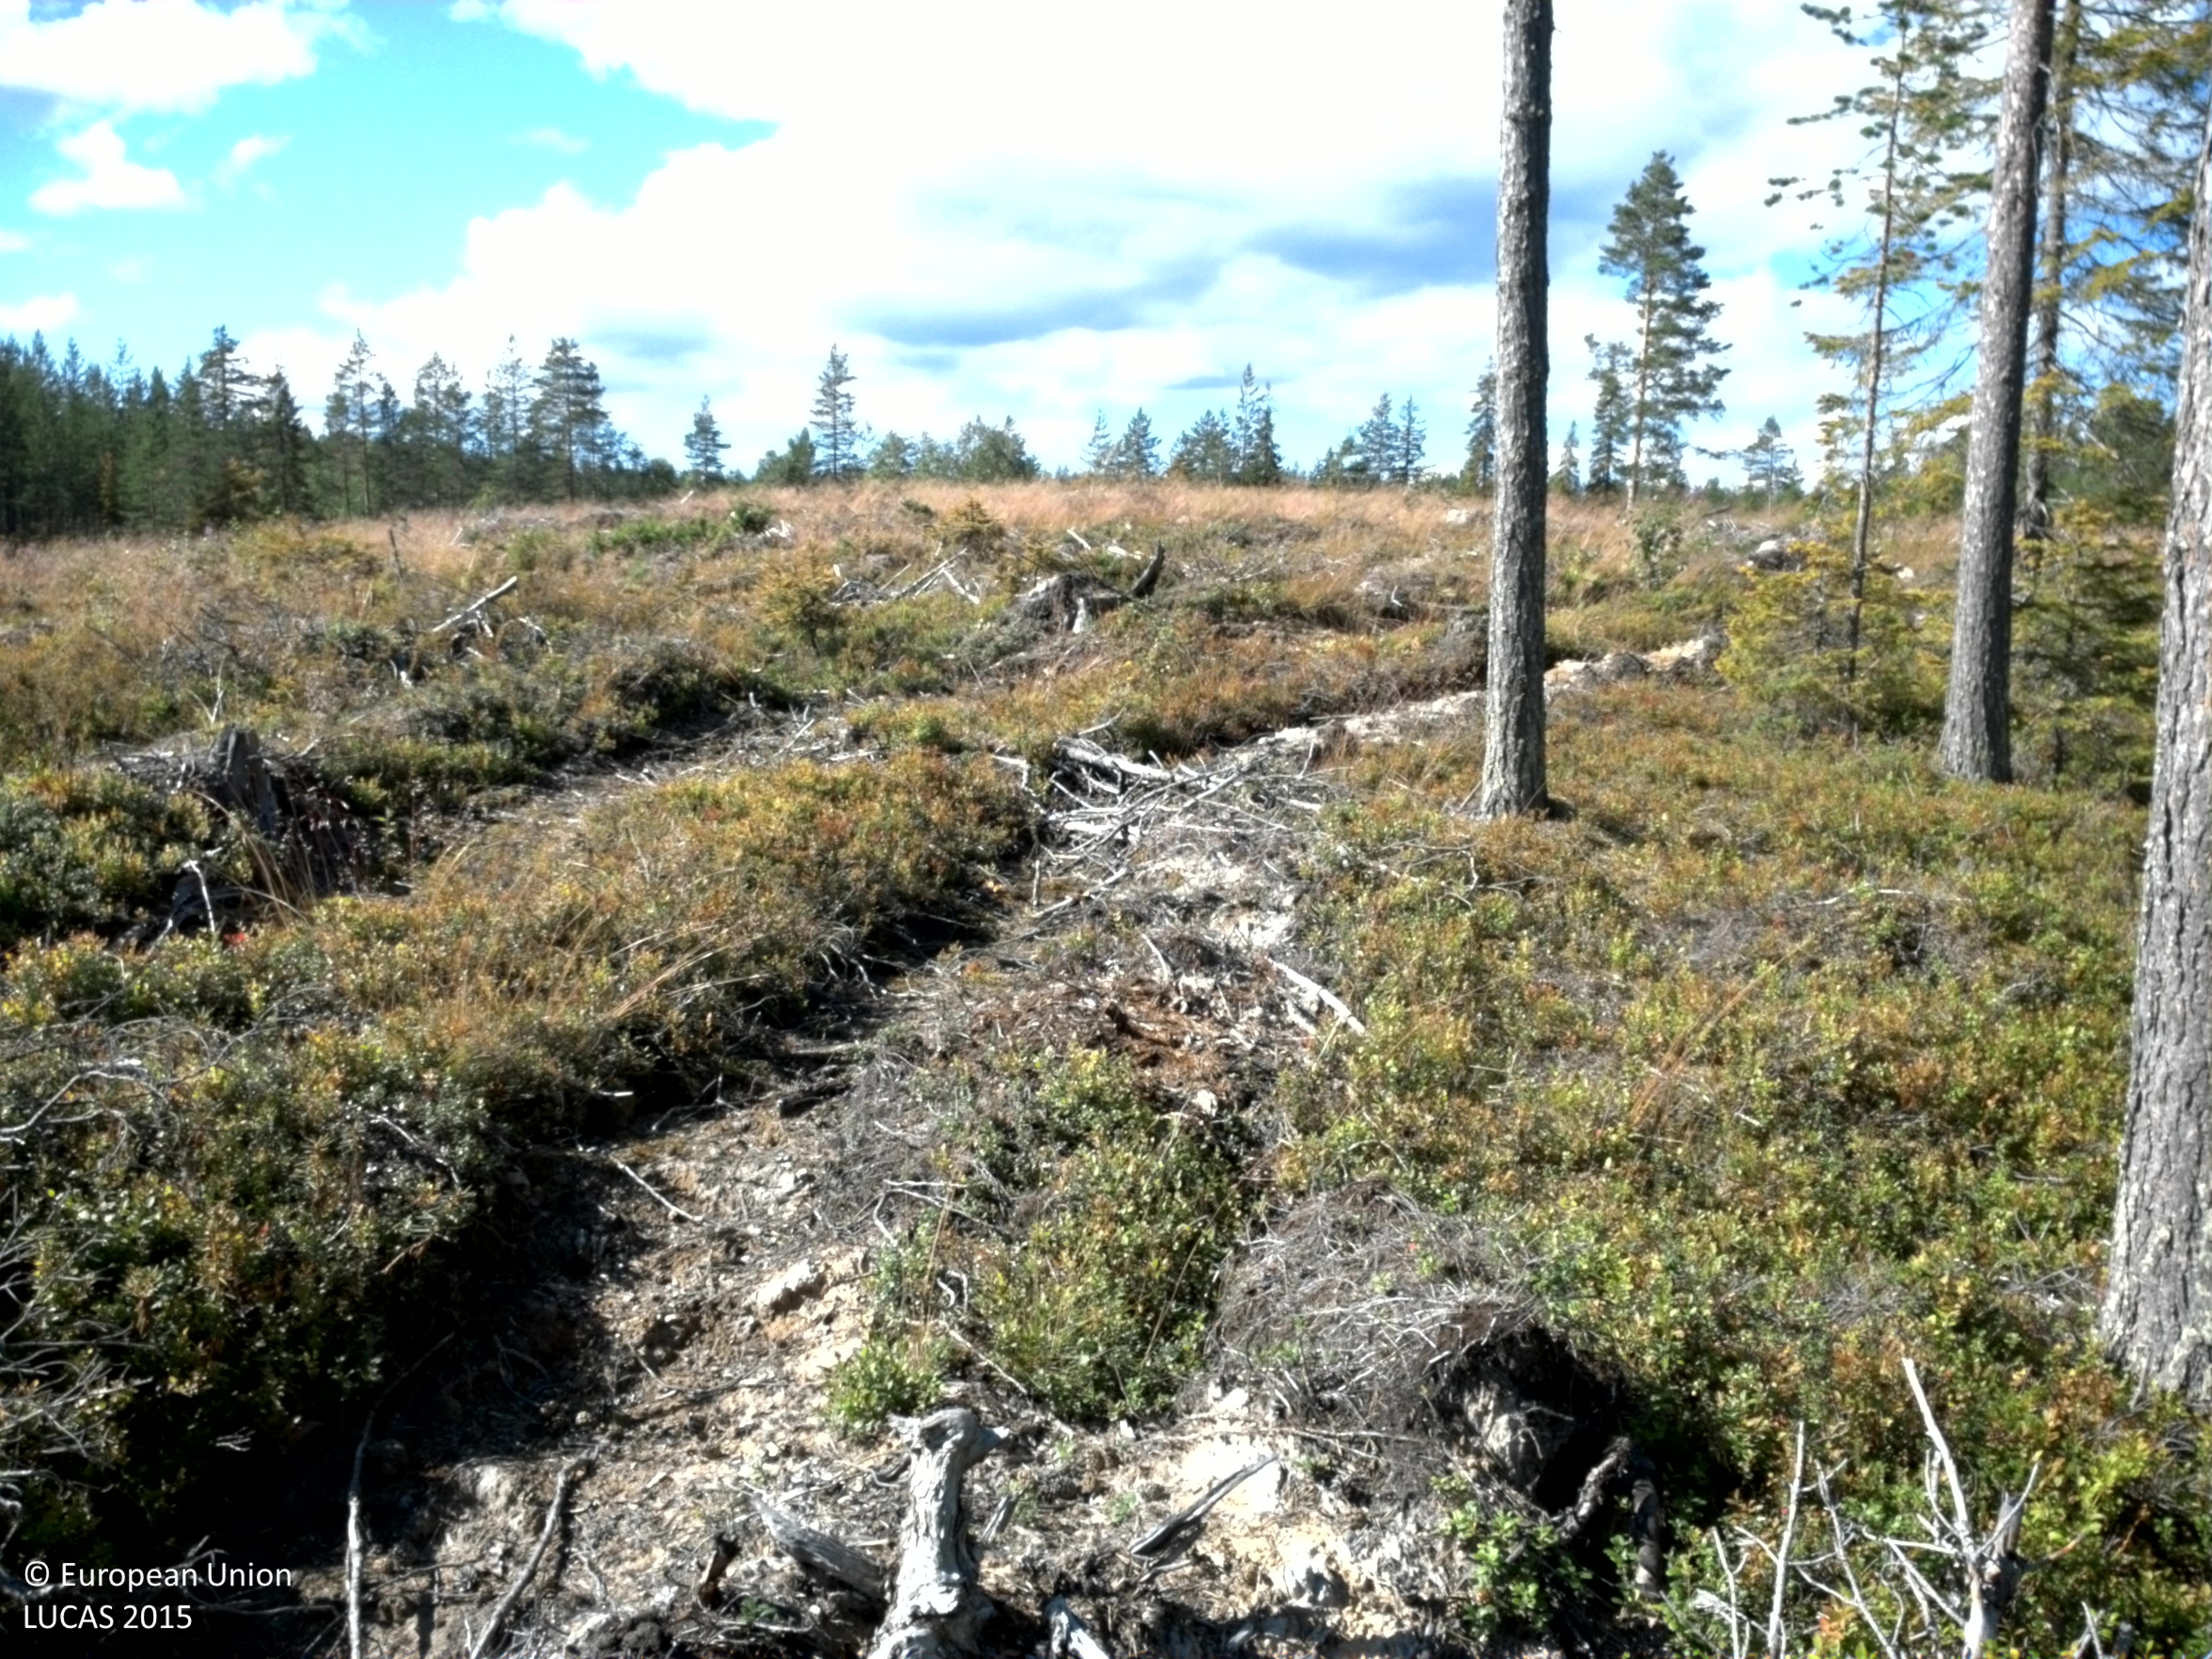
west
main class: Shrubland
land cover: Shrubland with sparse tree cover
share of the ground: > 75 %
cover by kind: shrubs 80 %, unconsolidated bare surface 15 %, coniferous forest trees 5 %
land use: Forestry
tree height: < 5 m
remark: Clear cut
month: August
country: SE
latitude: 66.0781
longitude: 22.5979
